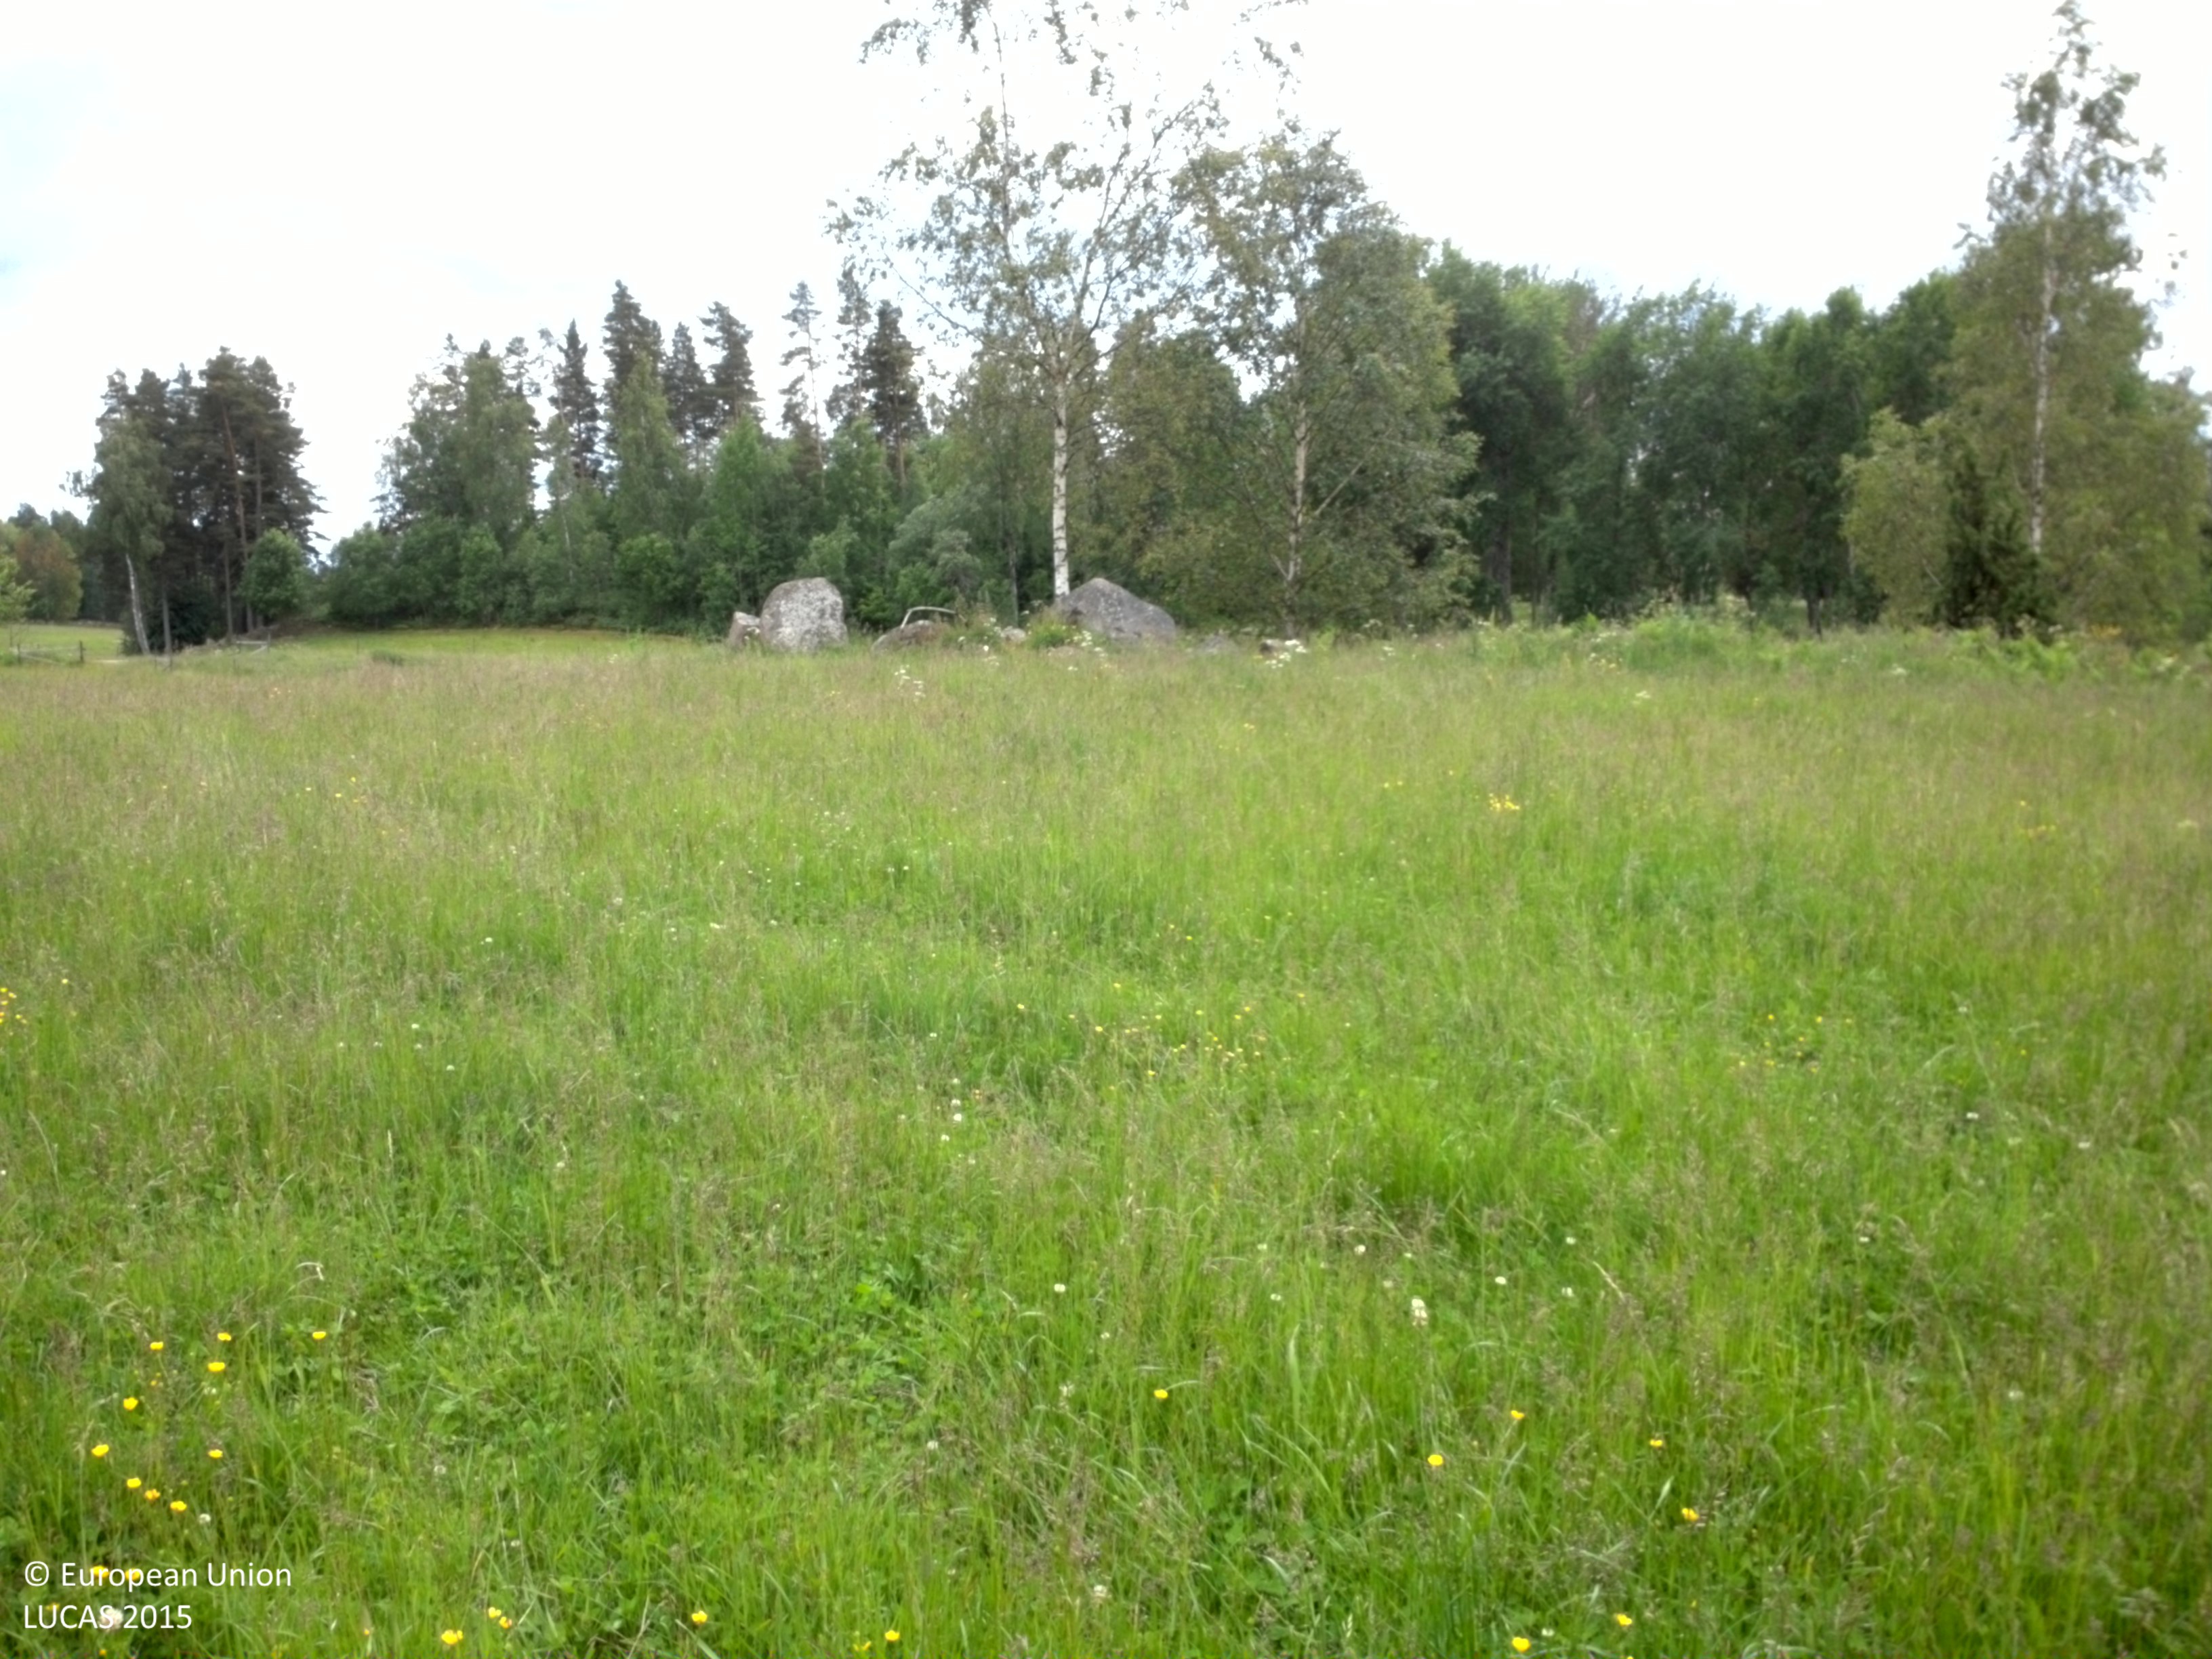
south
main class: Grassland
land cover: Grassland without tree/shrub cover
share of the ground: > 75 %
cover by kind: herbaceous plants 100 %
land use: Agriculture (excluding fallow land and kitchen gardens)
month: June
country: SE
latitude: 58.7173
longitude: 15.5706
